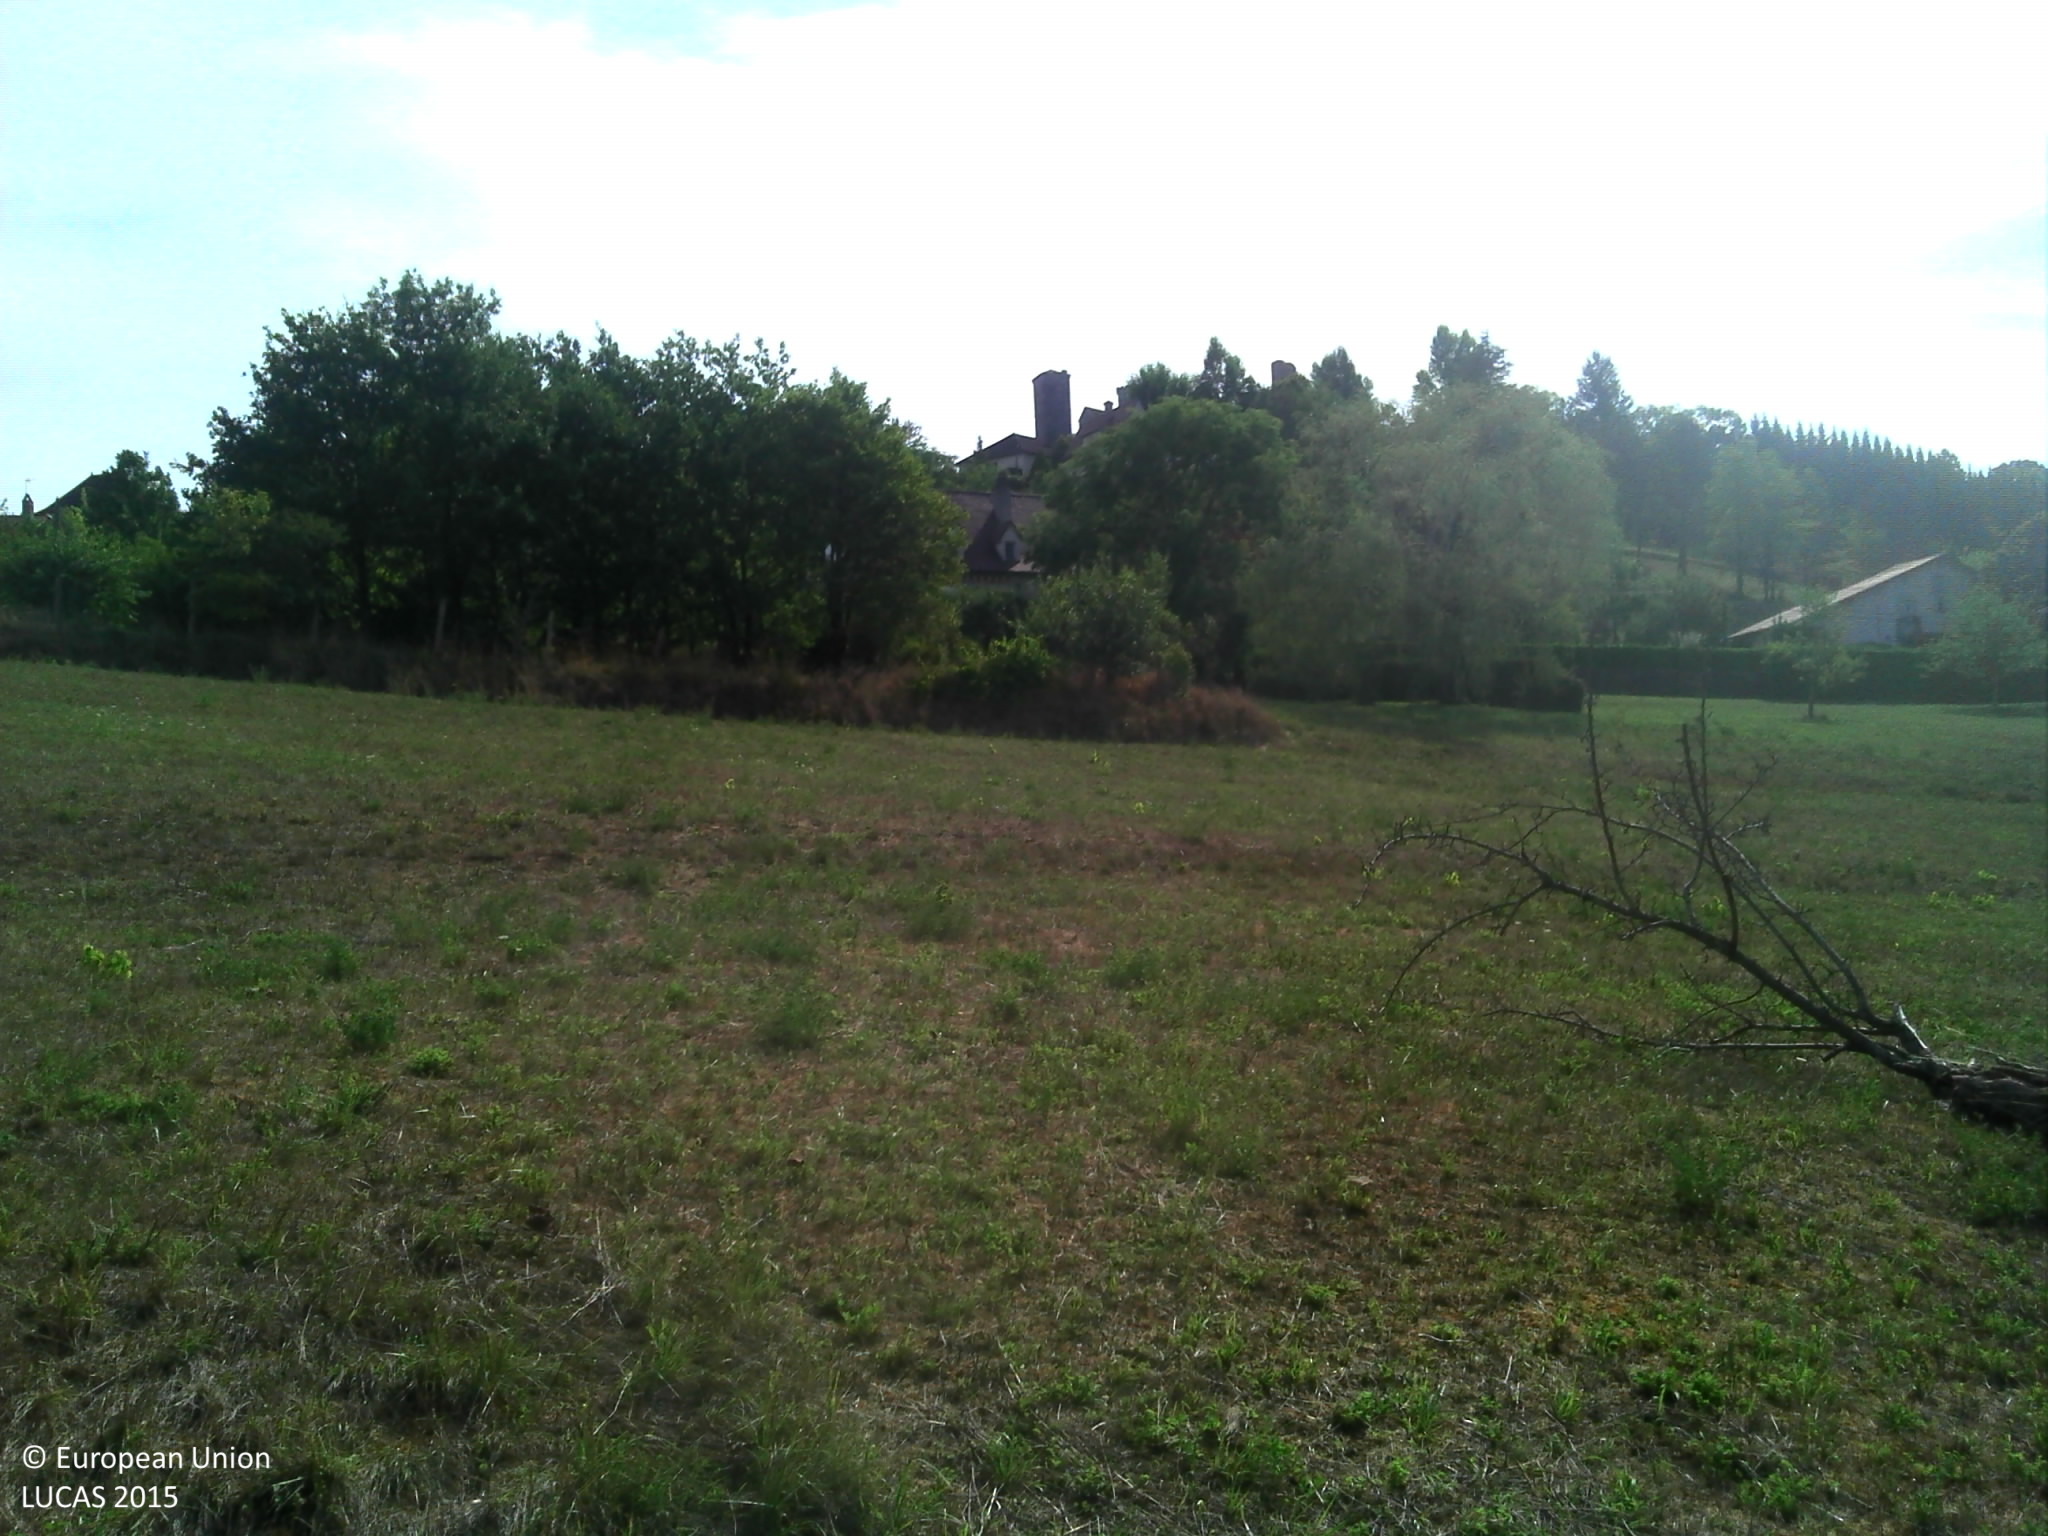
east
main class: Grassland
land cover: Grassland with sparse tree/shrub cover
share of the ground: > 75 %
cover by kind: herbaceous plants 85 %, shrubs 10 %, broadleaved forest trees 5 %
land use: Residential
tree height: > 5 m
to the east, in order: Fences; Grassland without tree/shrub cover; Artificial constructions in urban areas; Ditches and canals; Grassland with sparse tree/shrub cover; Artificial constructions in urban areas
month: August
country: FR
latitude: 44.8657
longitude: 1.8857
